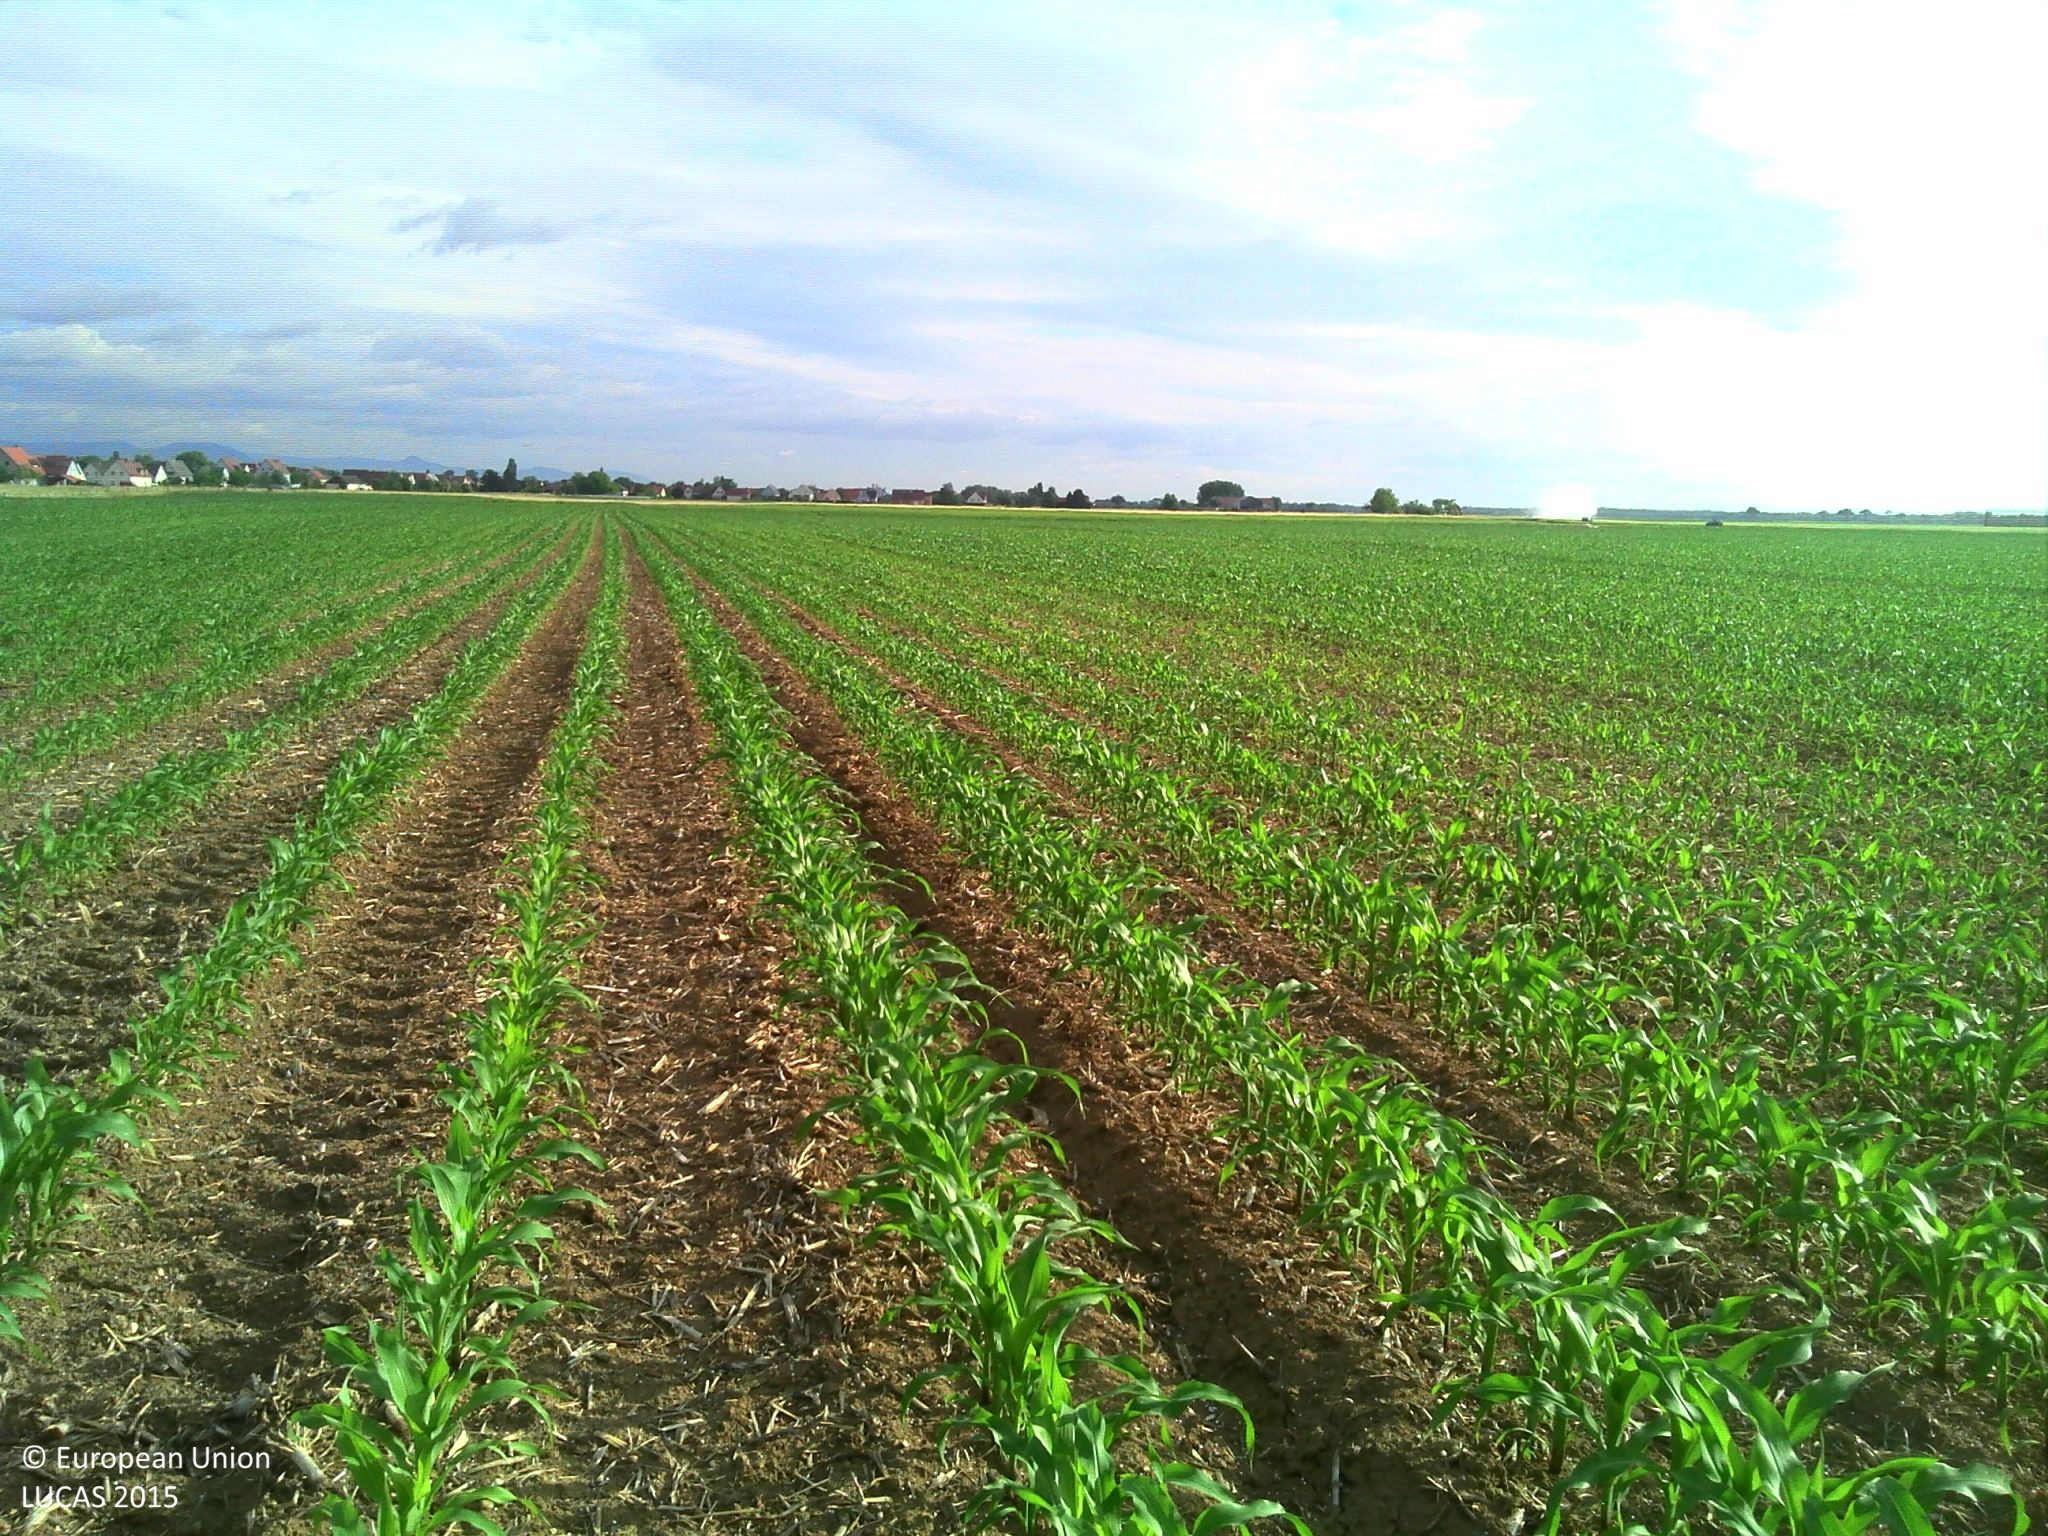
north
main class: Cropland
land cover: Maize
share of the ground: 10 - 25 %
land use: Agriculture (excluding fallow land and kitchen gardens)
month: June
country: FR
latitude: 48.0132
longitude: 7.4139
